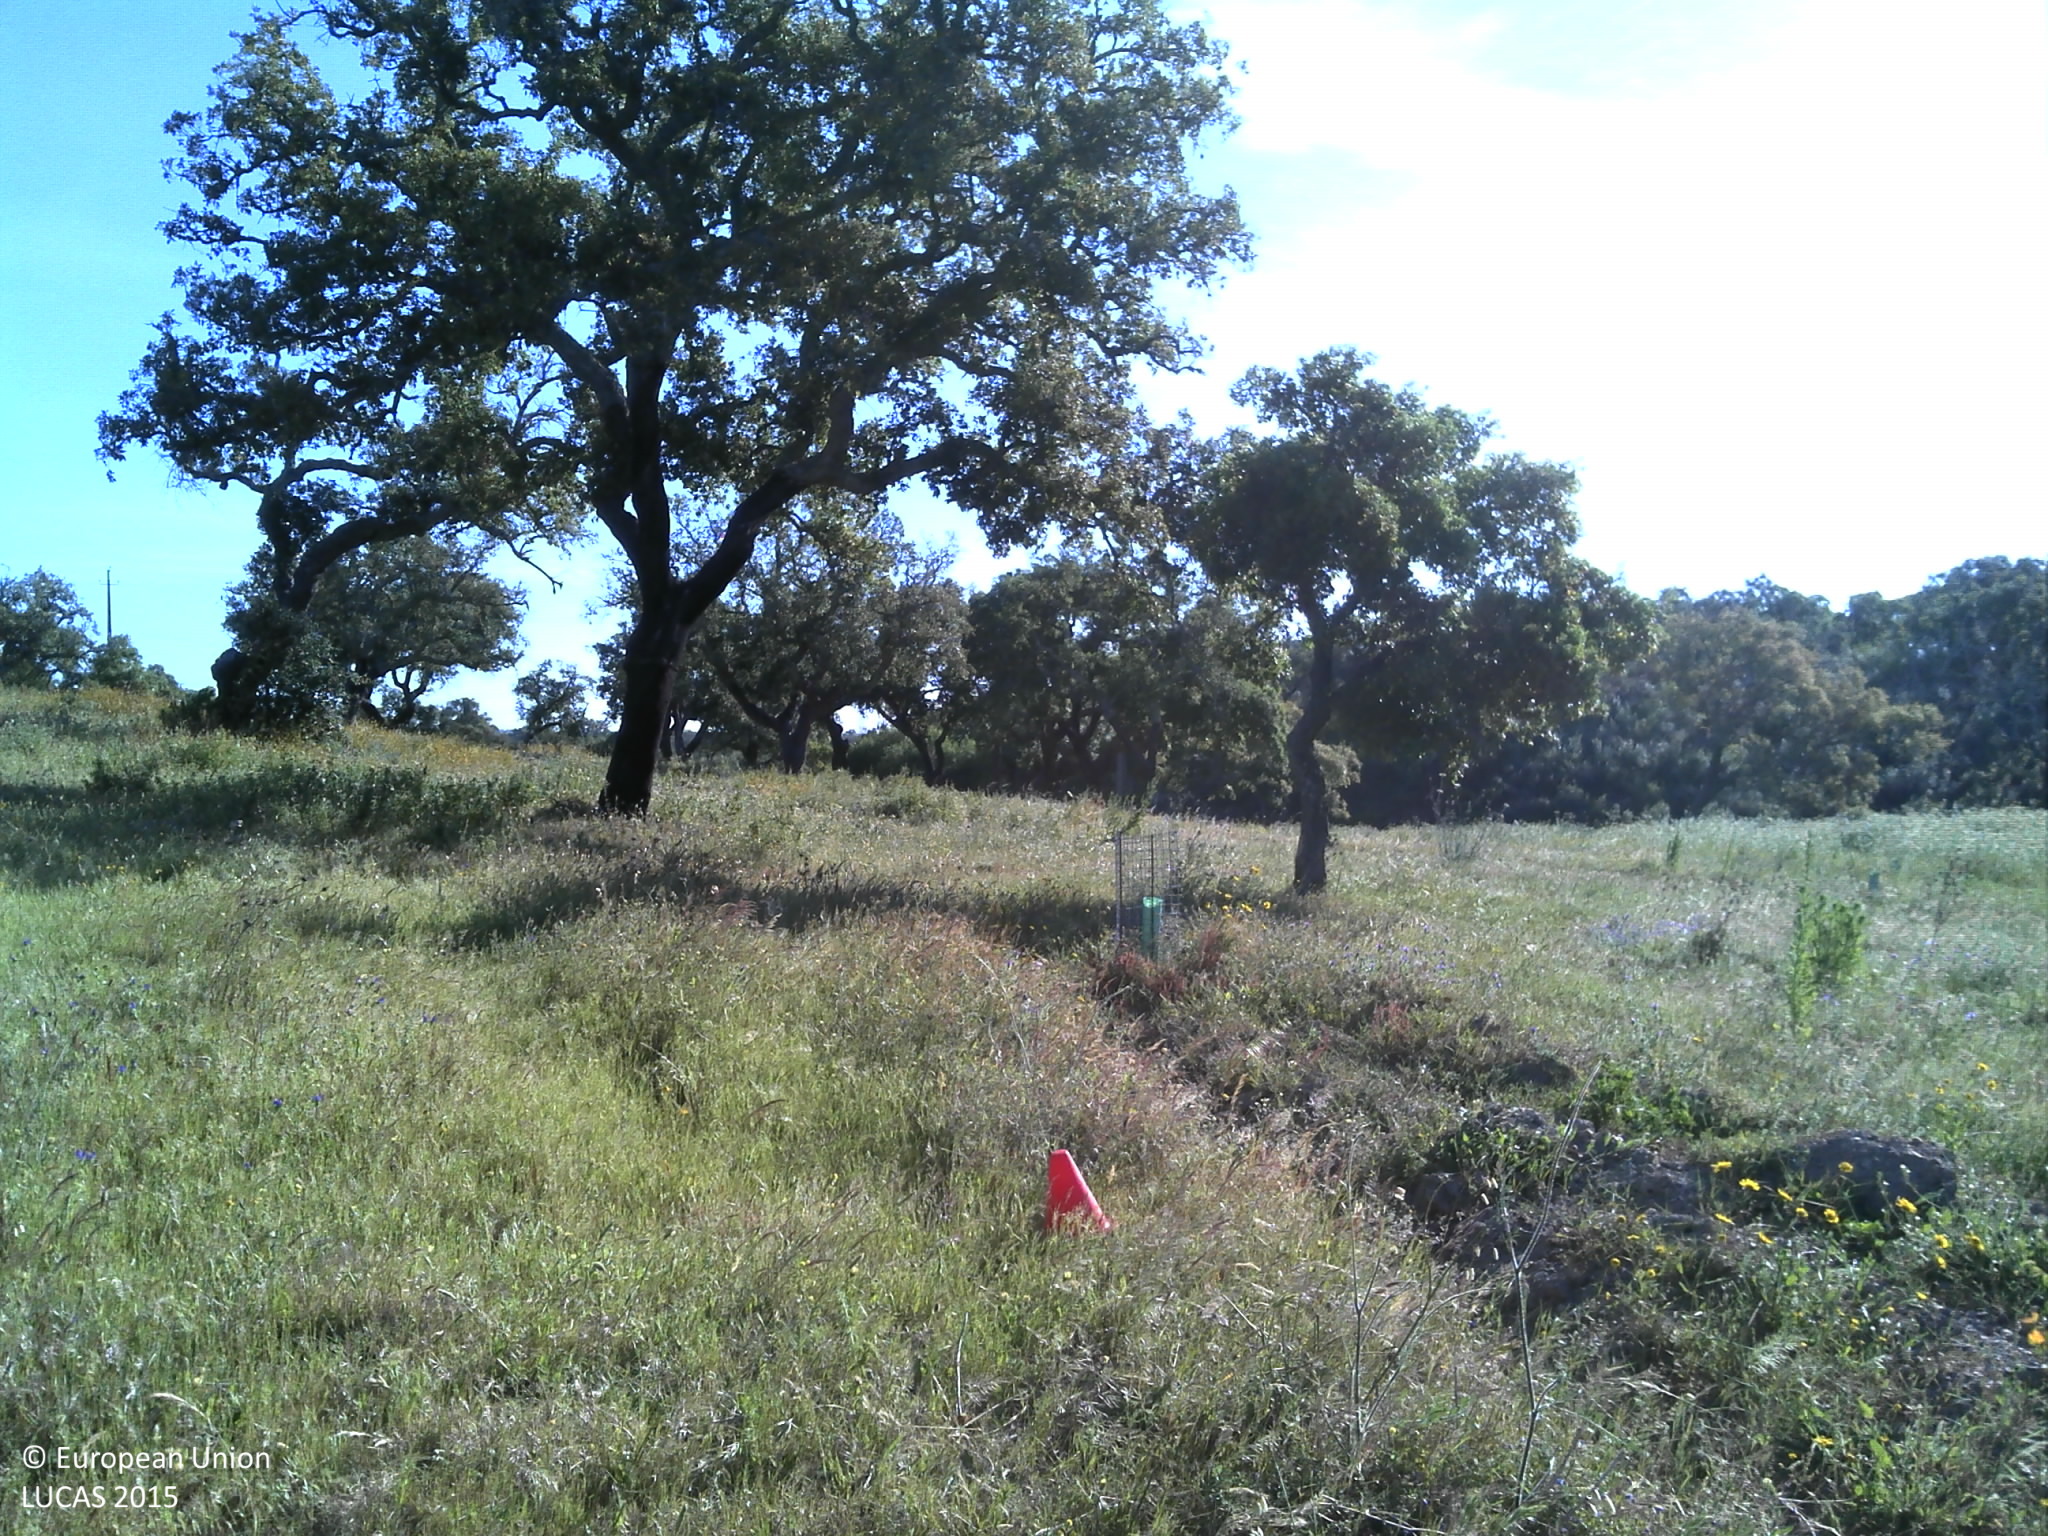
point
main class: Woodland
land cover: Broadleaved woodland
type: broadleaved evergreen forest
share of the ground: 10 - 25 %
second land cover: Grassland without tree/shrub cover
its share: > 75 %
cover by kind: herbaceous plants 75 %, broadleaved forest trees 20 %, unconsolidated bare surface 5 %
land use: Forestry
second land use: Agriculture (excluding fallow land and kitchen gardens)
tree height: > 5 m
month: May
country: PT
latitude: 38.0213
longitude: -8.6258
